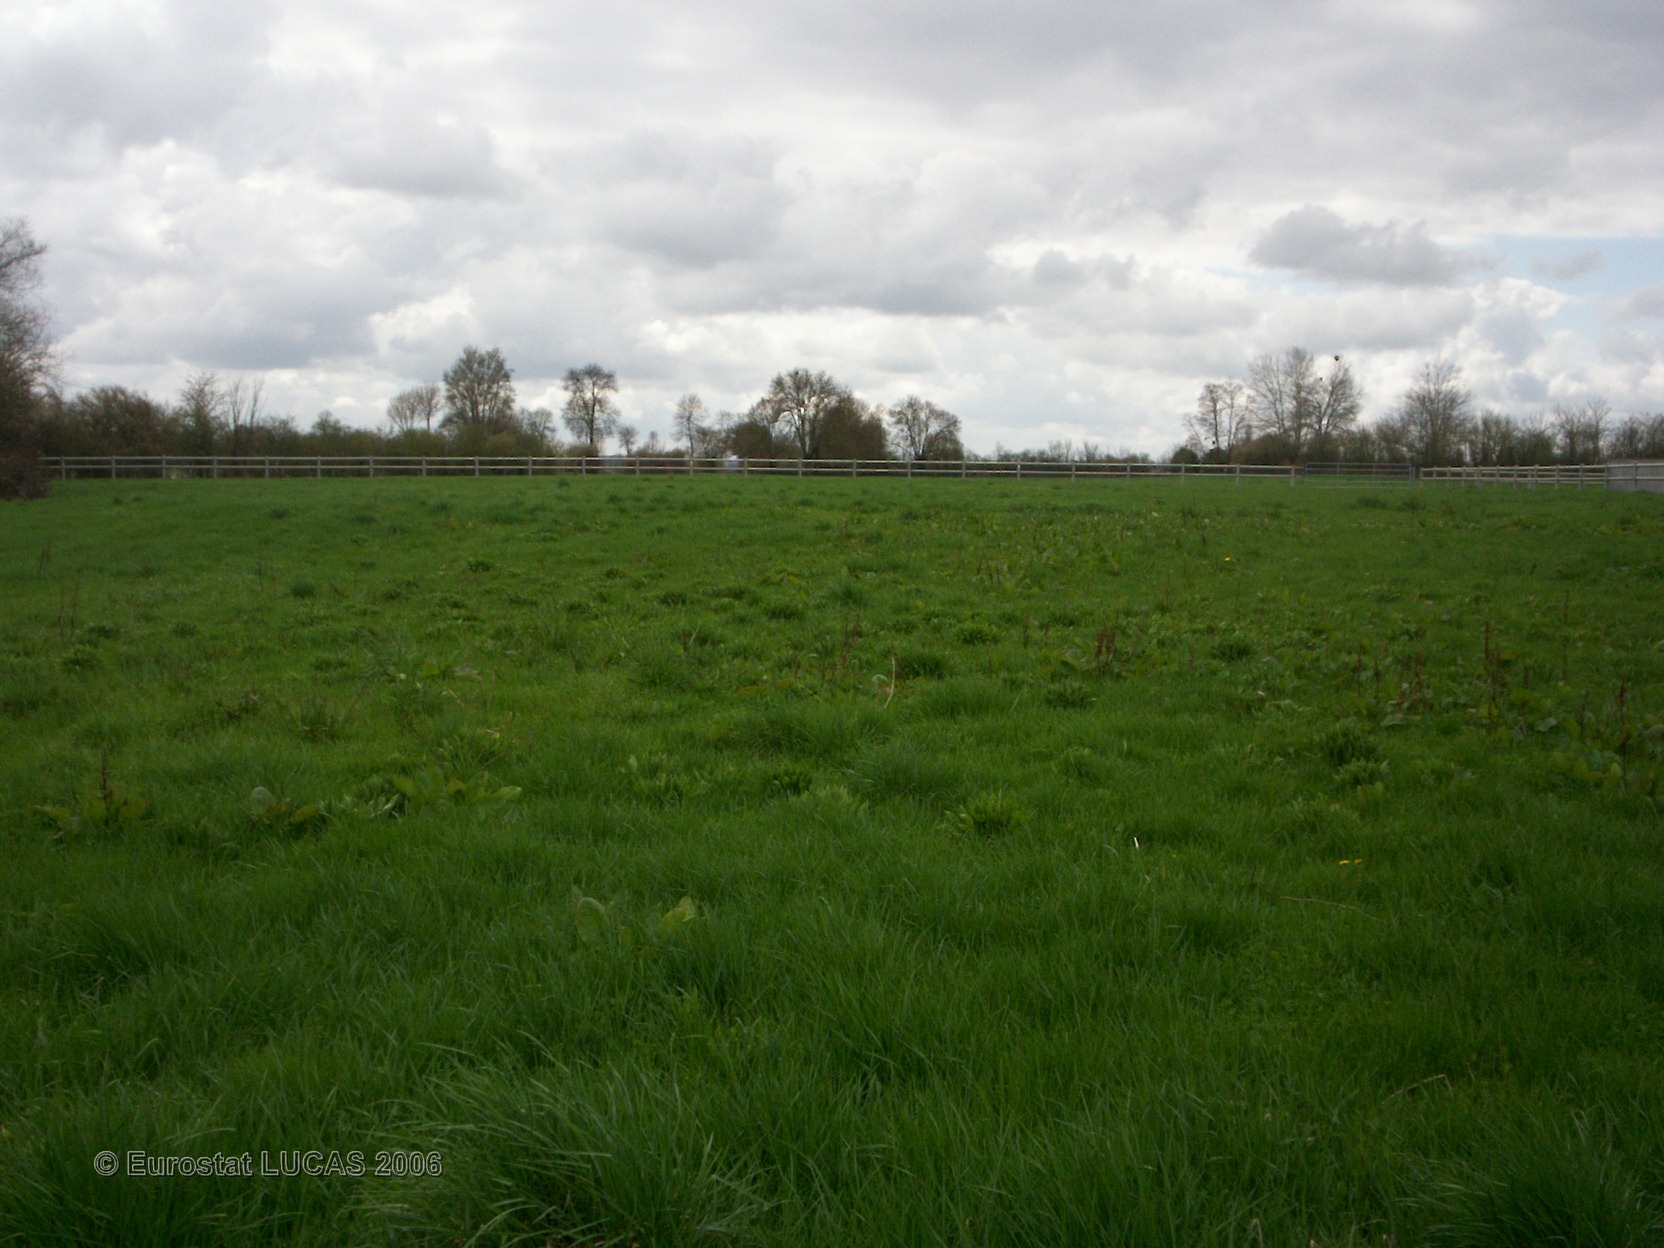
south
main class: Grassland
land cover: Grassland without tree/shrub cover
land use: Agriculture (excluding fallow land and kitchen gardens)
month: April
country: FR
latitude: 46.8502
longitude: 3.0850
